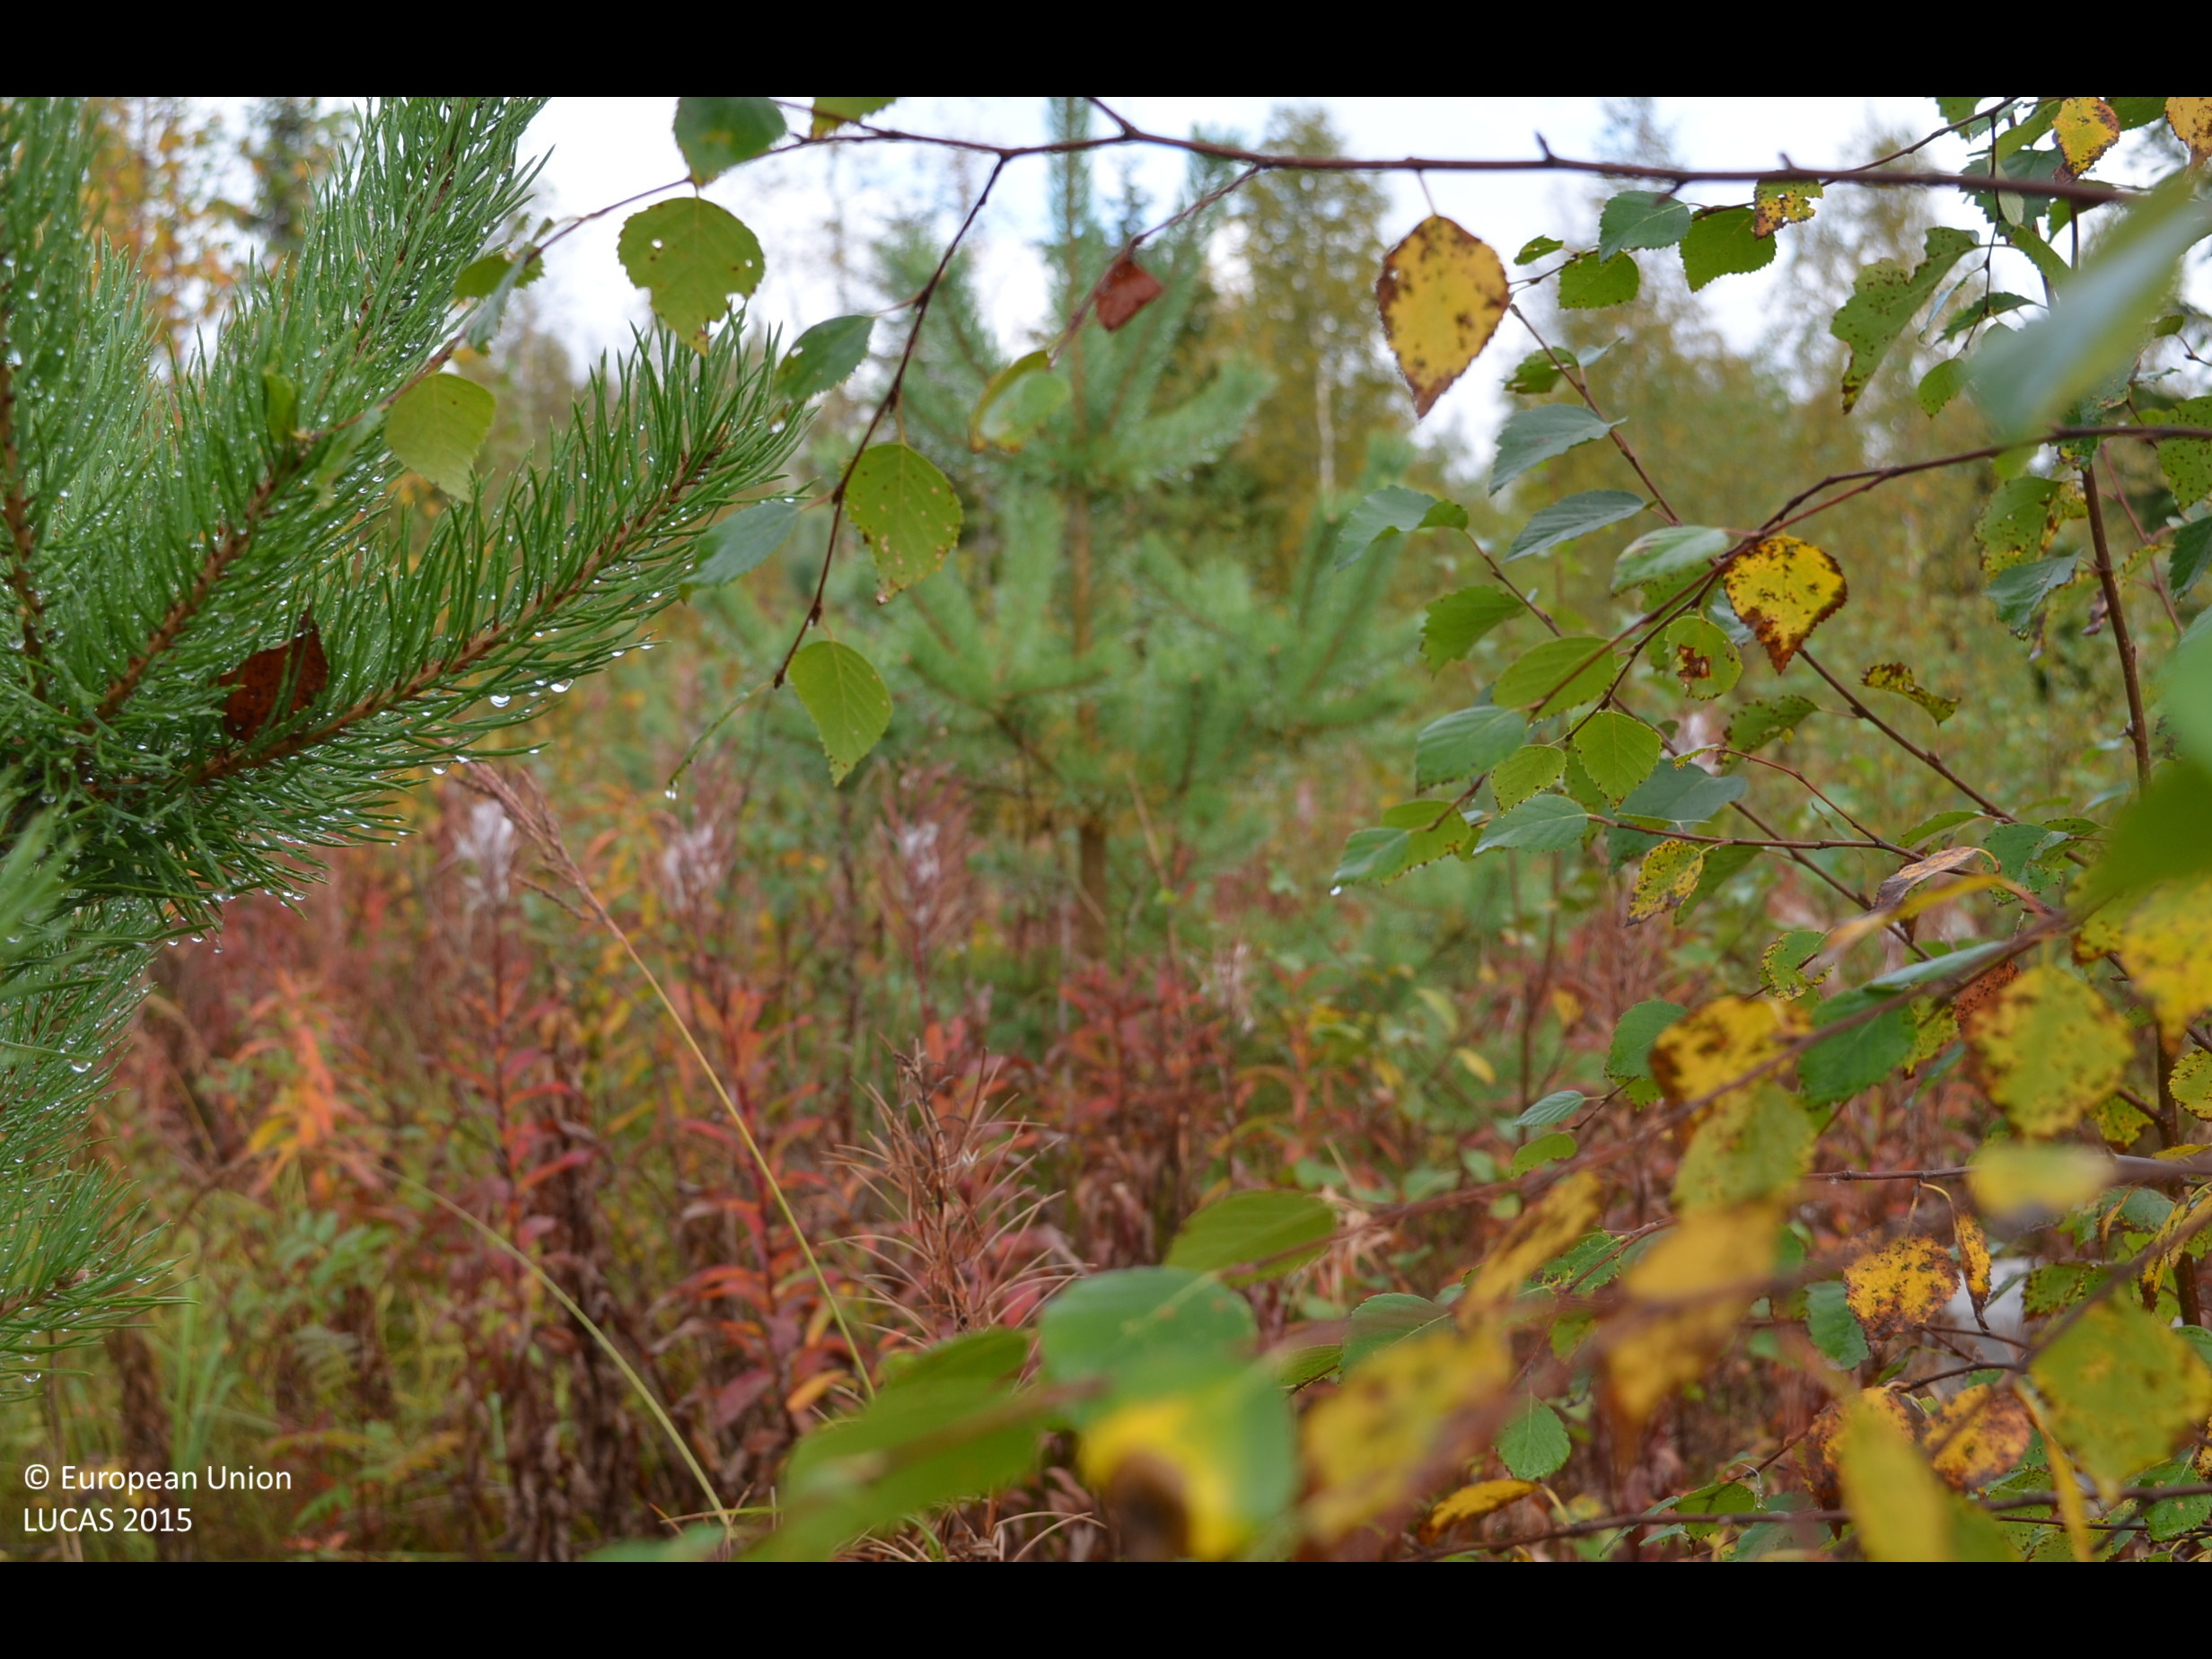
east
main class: Woodland
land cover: Pine dominated mixed woodland
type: boreal forest
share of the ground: 50 - 75 %
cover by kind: broadleaved forest trees 40 %, coniferous forest trees 30 %, herbaceous plants 15 %, shrubs 10 %, lichens and mosses 5 %
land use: Forestry
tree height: < 5 m
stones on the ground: < 10 %
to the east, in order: Pine dominated mixed woodland; Ditches and canals; Pine dominated mixed woodland; Ditches and canals; Grassland without tree/shrub cover; Ditches and canals; Broadleaved woodland; Ditches and canals; Broadleaved woodland; Other mixed woodland; Broadleaved woodland; Pine dominated mixed woodland; Other mixed woodland; Pine dominated mixed woodland; Other mixed woodland
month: September
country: FI
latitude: 62.9735
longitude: 23.9016
